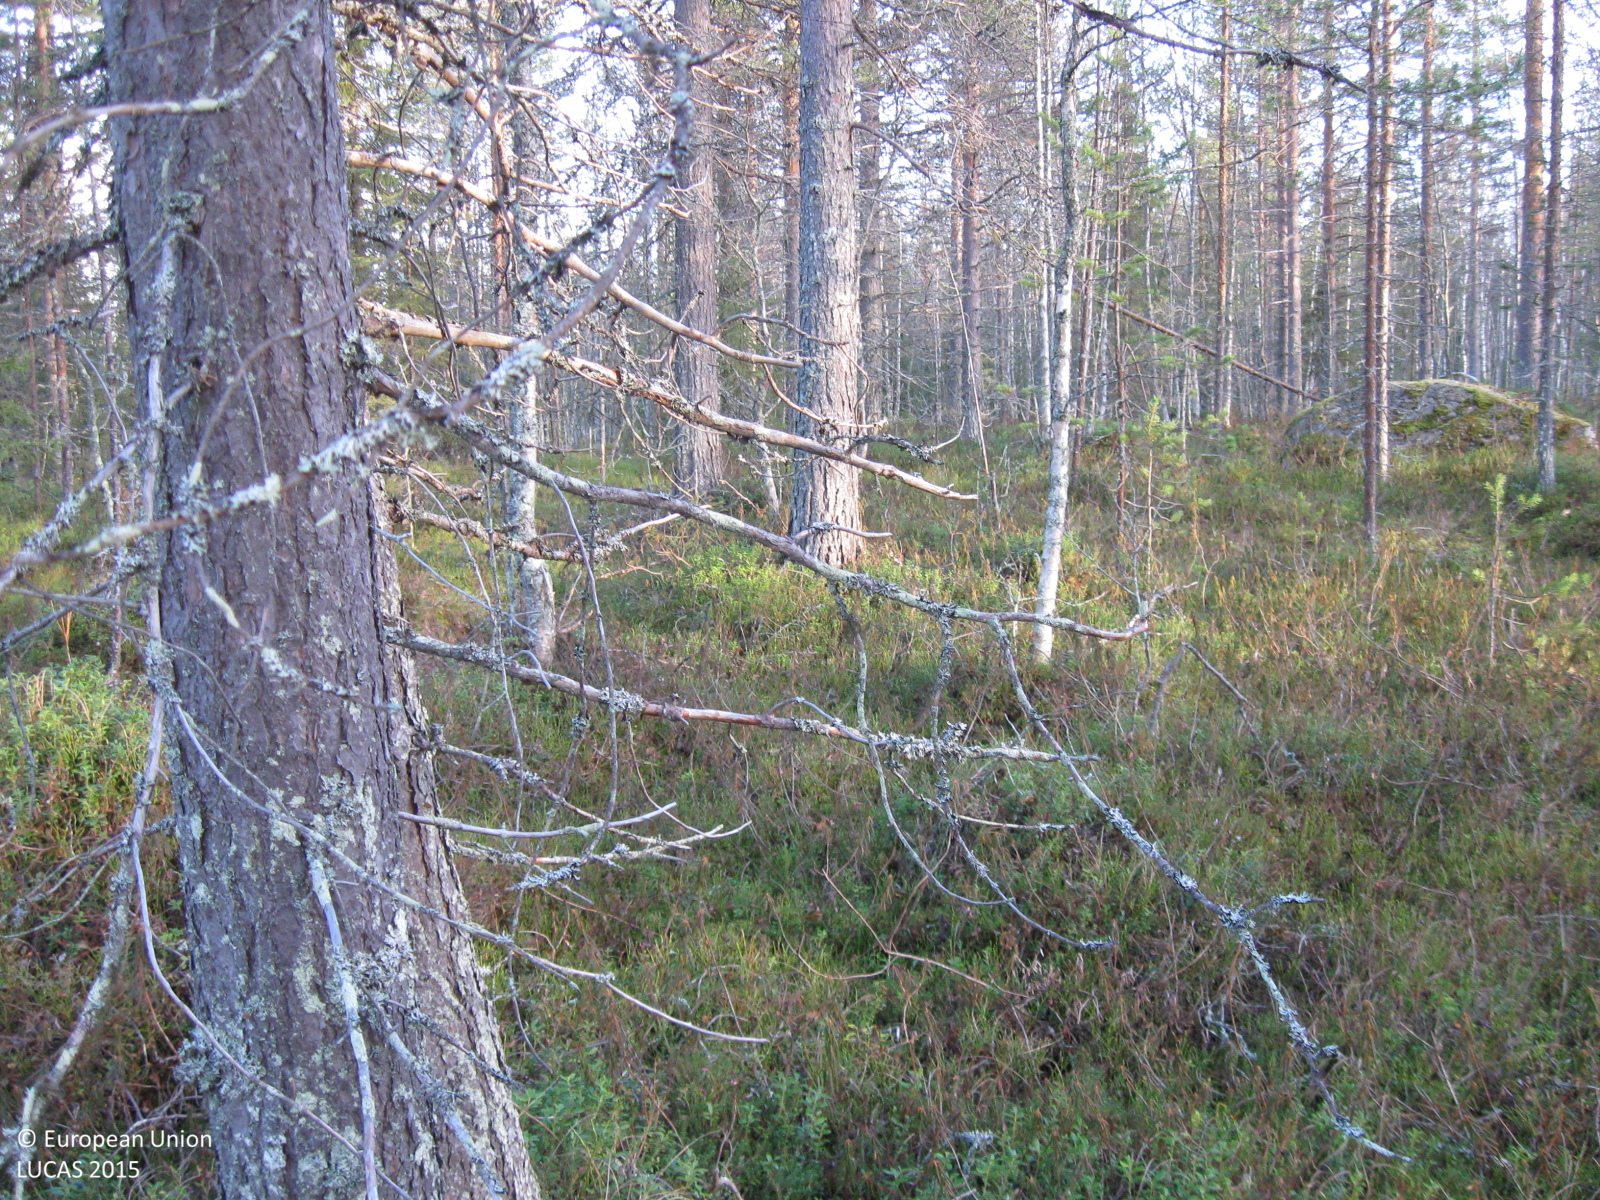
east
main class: Woodland
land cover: Pine dominated mixed woodland
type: boreal forest
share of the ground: > 75 %
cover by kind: coniferous forest trees 60 %, broadleaved forest trees 20 %, shrubs 10 %, herbaceous plants 5 %, lichens and mosses 5 %
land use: Forestry
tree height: > 5 m
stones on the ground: 10 - 25 %
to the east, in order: Pine dominated mixed woodland; Ditches and canals; Pine dominated mixed woodland; Ditches and canals; Pine dominated coniferous woodland; Rivers and streams; Broadleaved woodland; Other mixed woodland
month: October
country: SE
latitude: 66.2198
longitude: 22.1733
